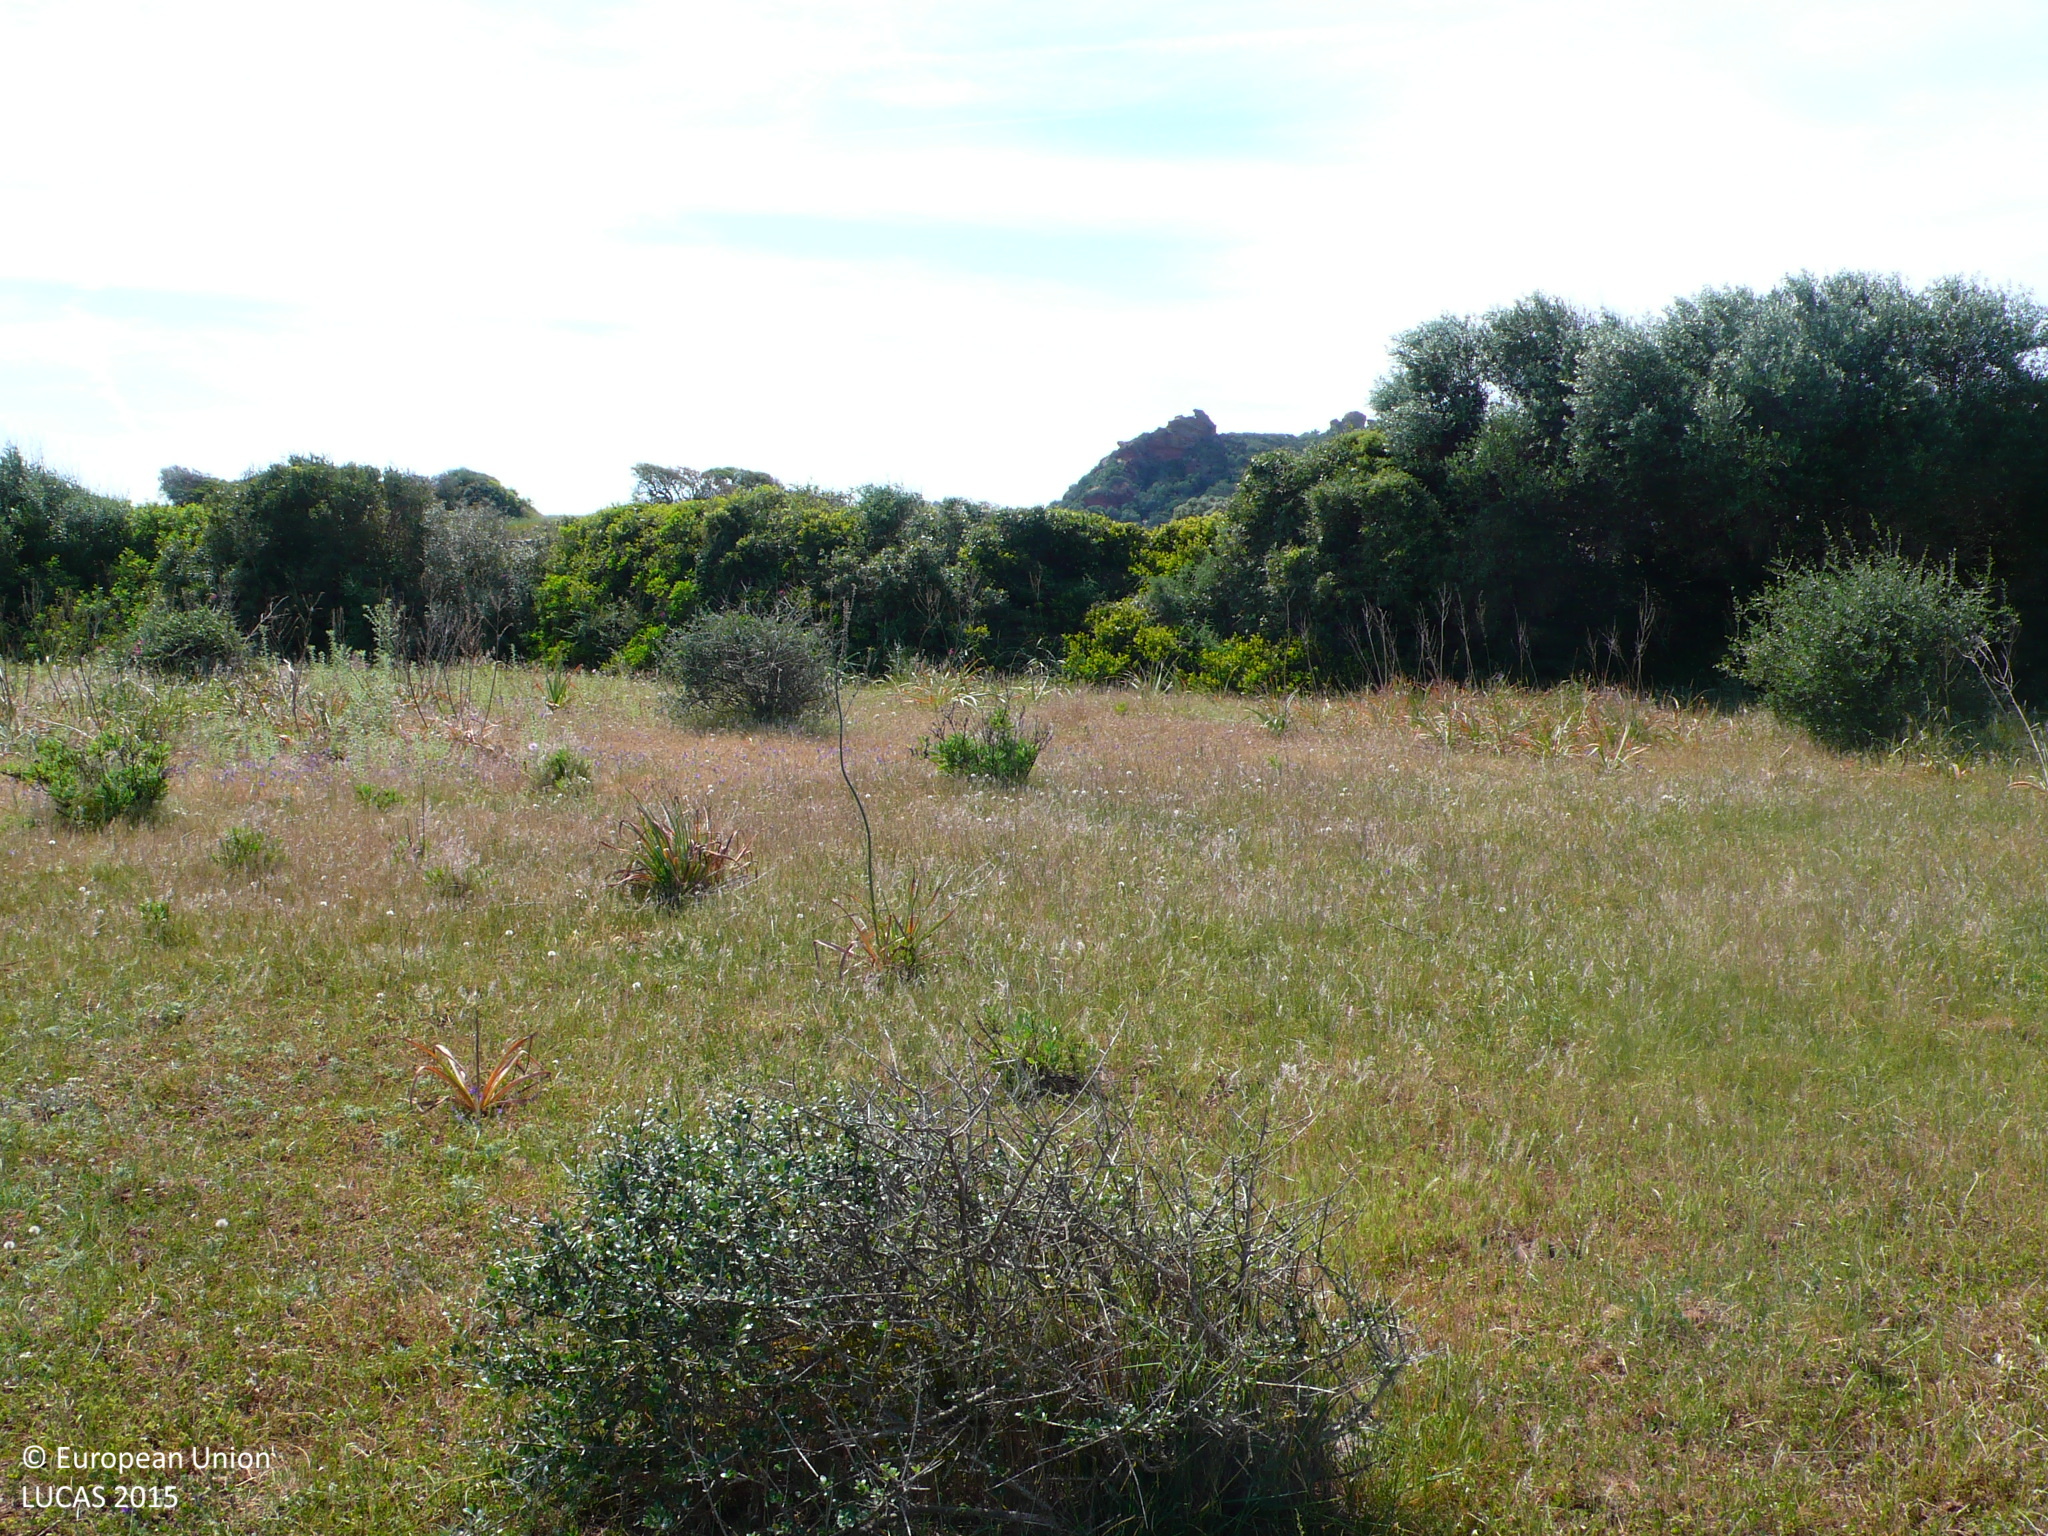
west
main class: Grassland
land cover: Grassland with sparse tree/shrub cover
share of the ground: > 75 %
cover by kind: herbaceous plants 90 %, broadleaved forest trees 5 %, shrubs 5 %
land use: Agriculture (excluding fallow land and kitchen gardens)
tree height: < 5 m
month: May
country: ES
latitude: 39.9524
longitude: 4.2318
